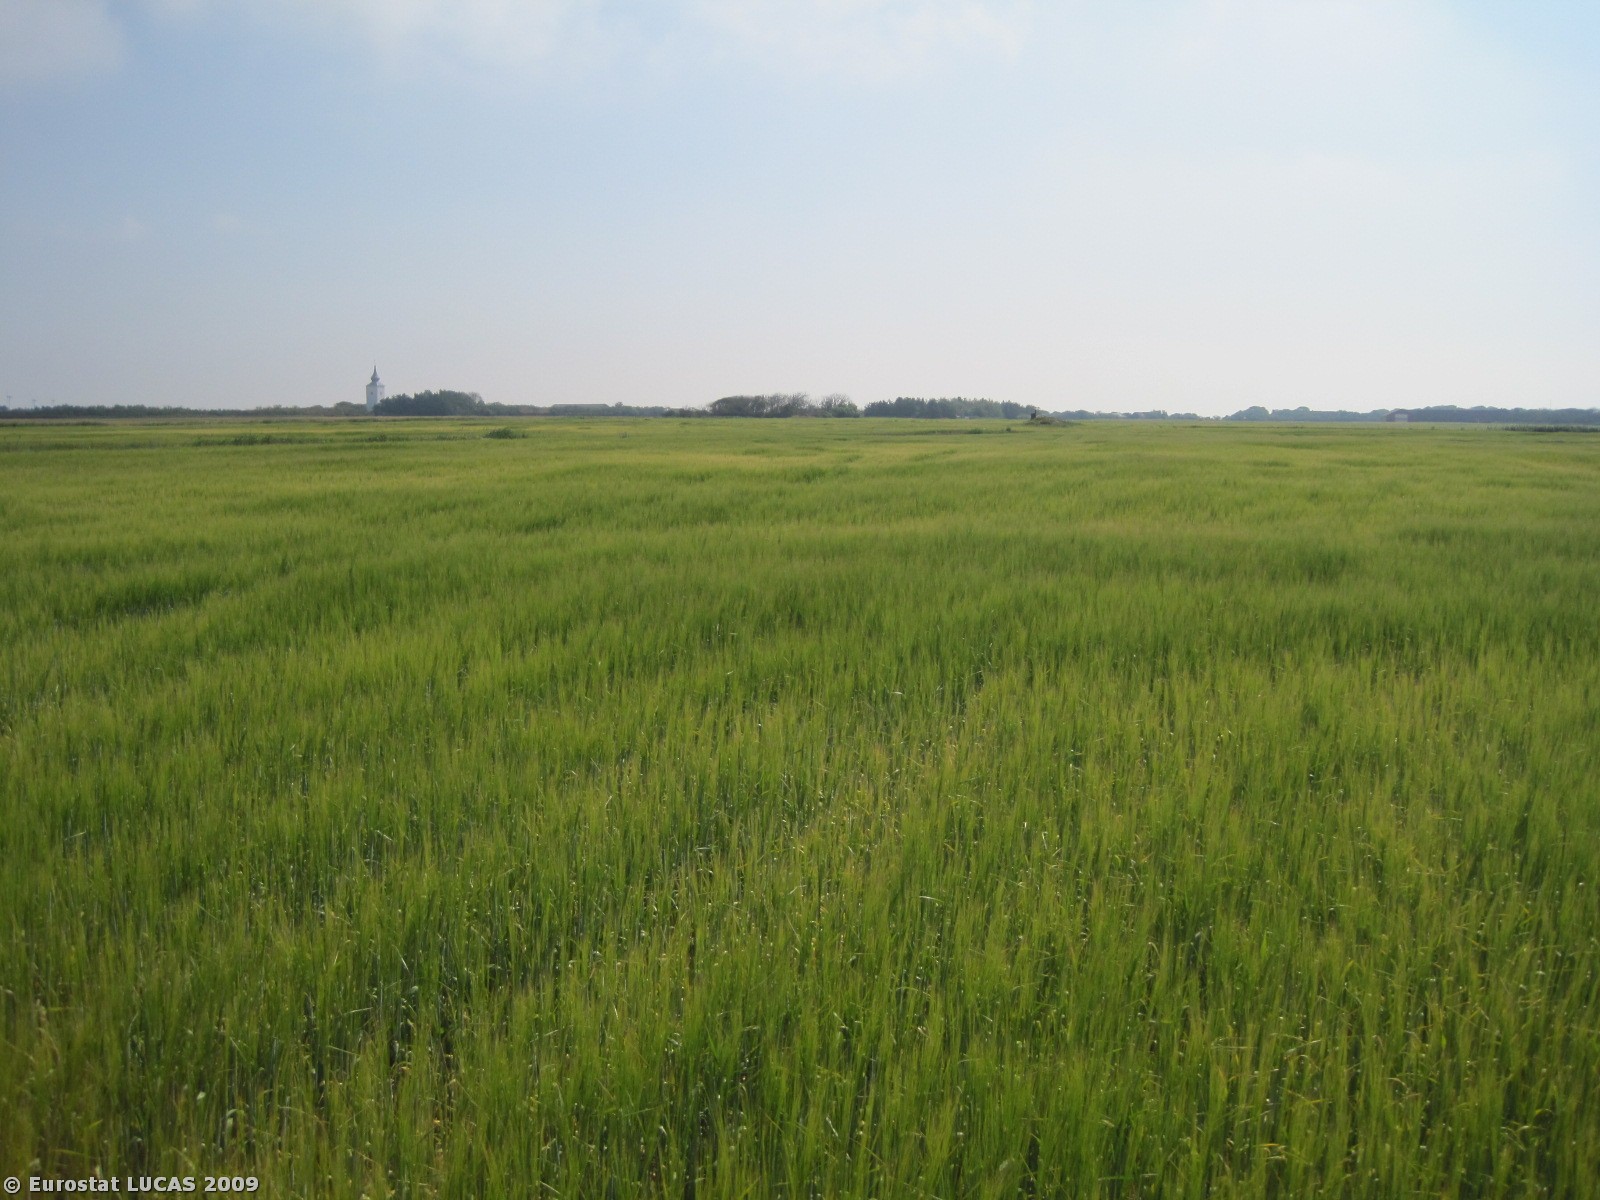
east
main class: Cropland
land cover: Barley
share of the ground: > 75 %
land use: Agriculture (excluding fallow land and kitchen gardens)
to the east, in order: Barley; Grass margins; Barley; Grassland without tree/shrub cover; Barley; Grassland without tree/shrub cover; Ditches and canals; Grass margins; Barley
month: July
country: DK
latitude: 56.4444
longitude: 8.1691
